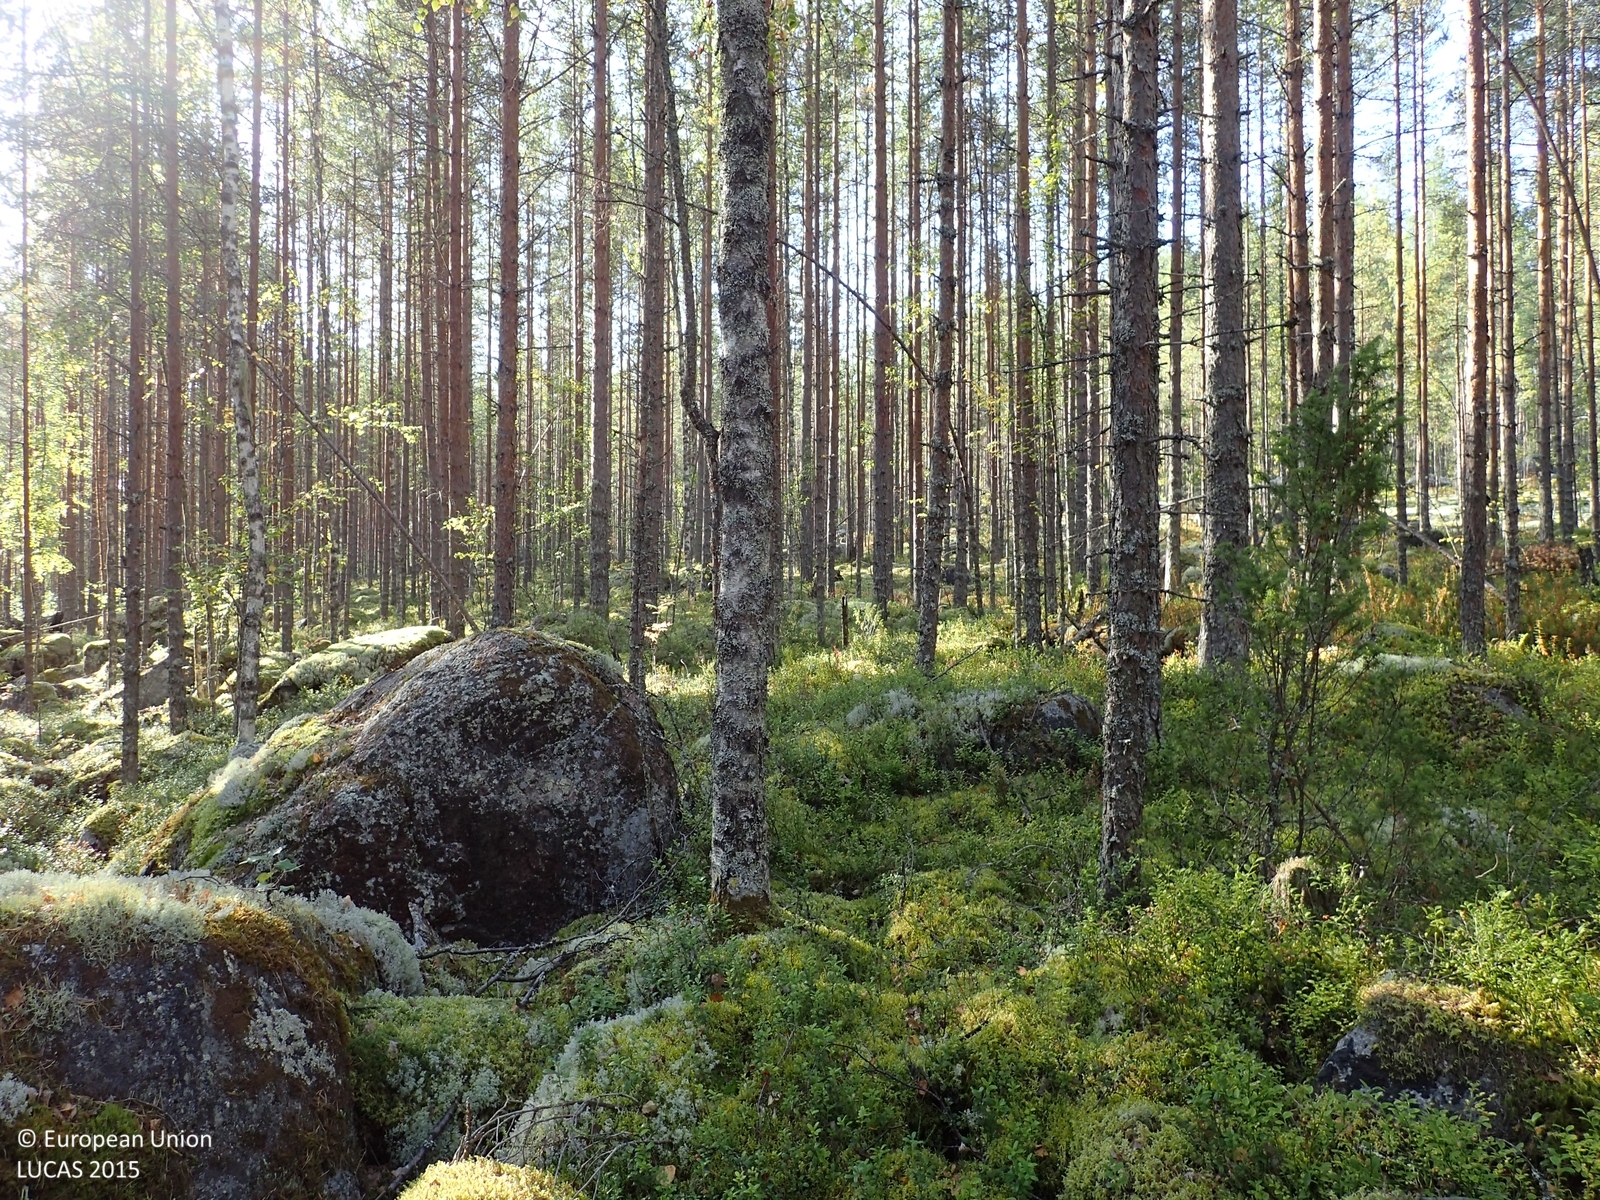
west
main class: Woodland
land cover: Pine dominated coniferous woodland
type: boreal forest
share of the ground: > 75 %
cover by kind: coniferous forest trees 65 %, shrubs 15 %, broadleaved forest trees 10 %, lichens and mosses 5 %, consolidated bare surface 5 %
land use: Forestry
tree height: > 5 m
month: September
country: FI
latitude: 62.9310
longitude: 25.2891
